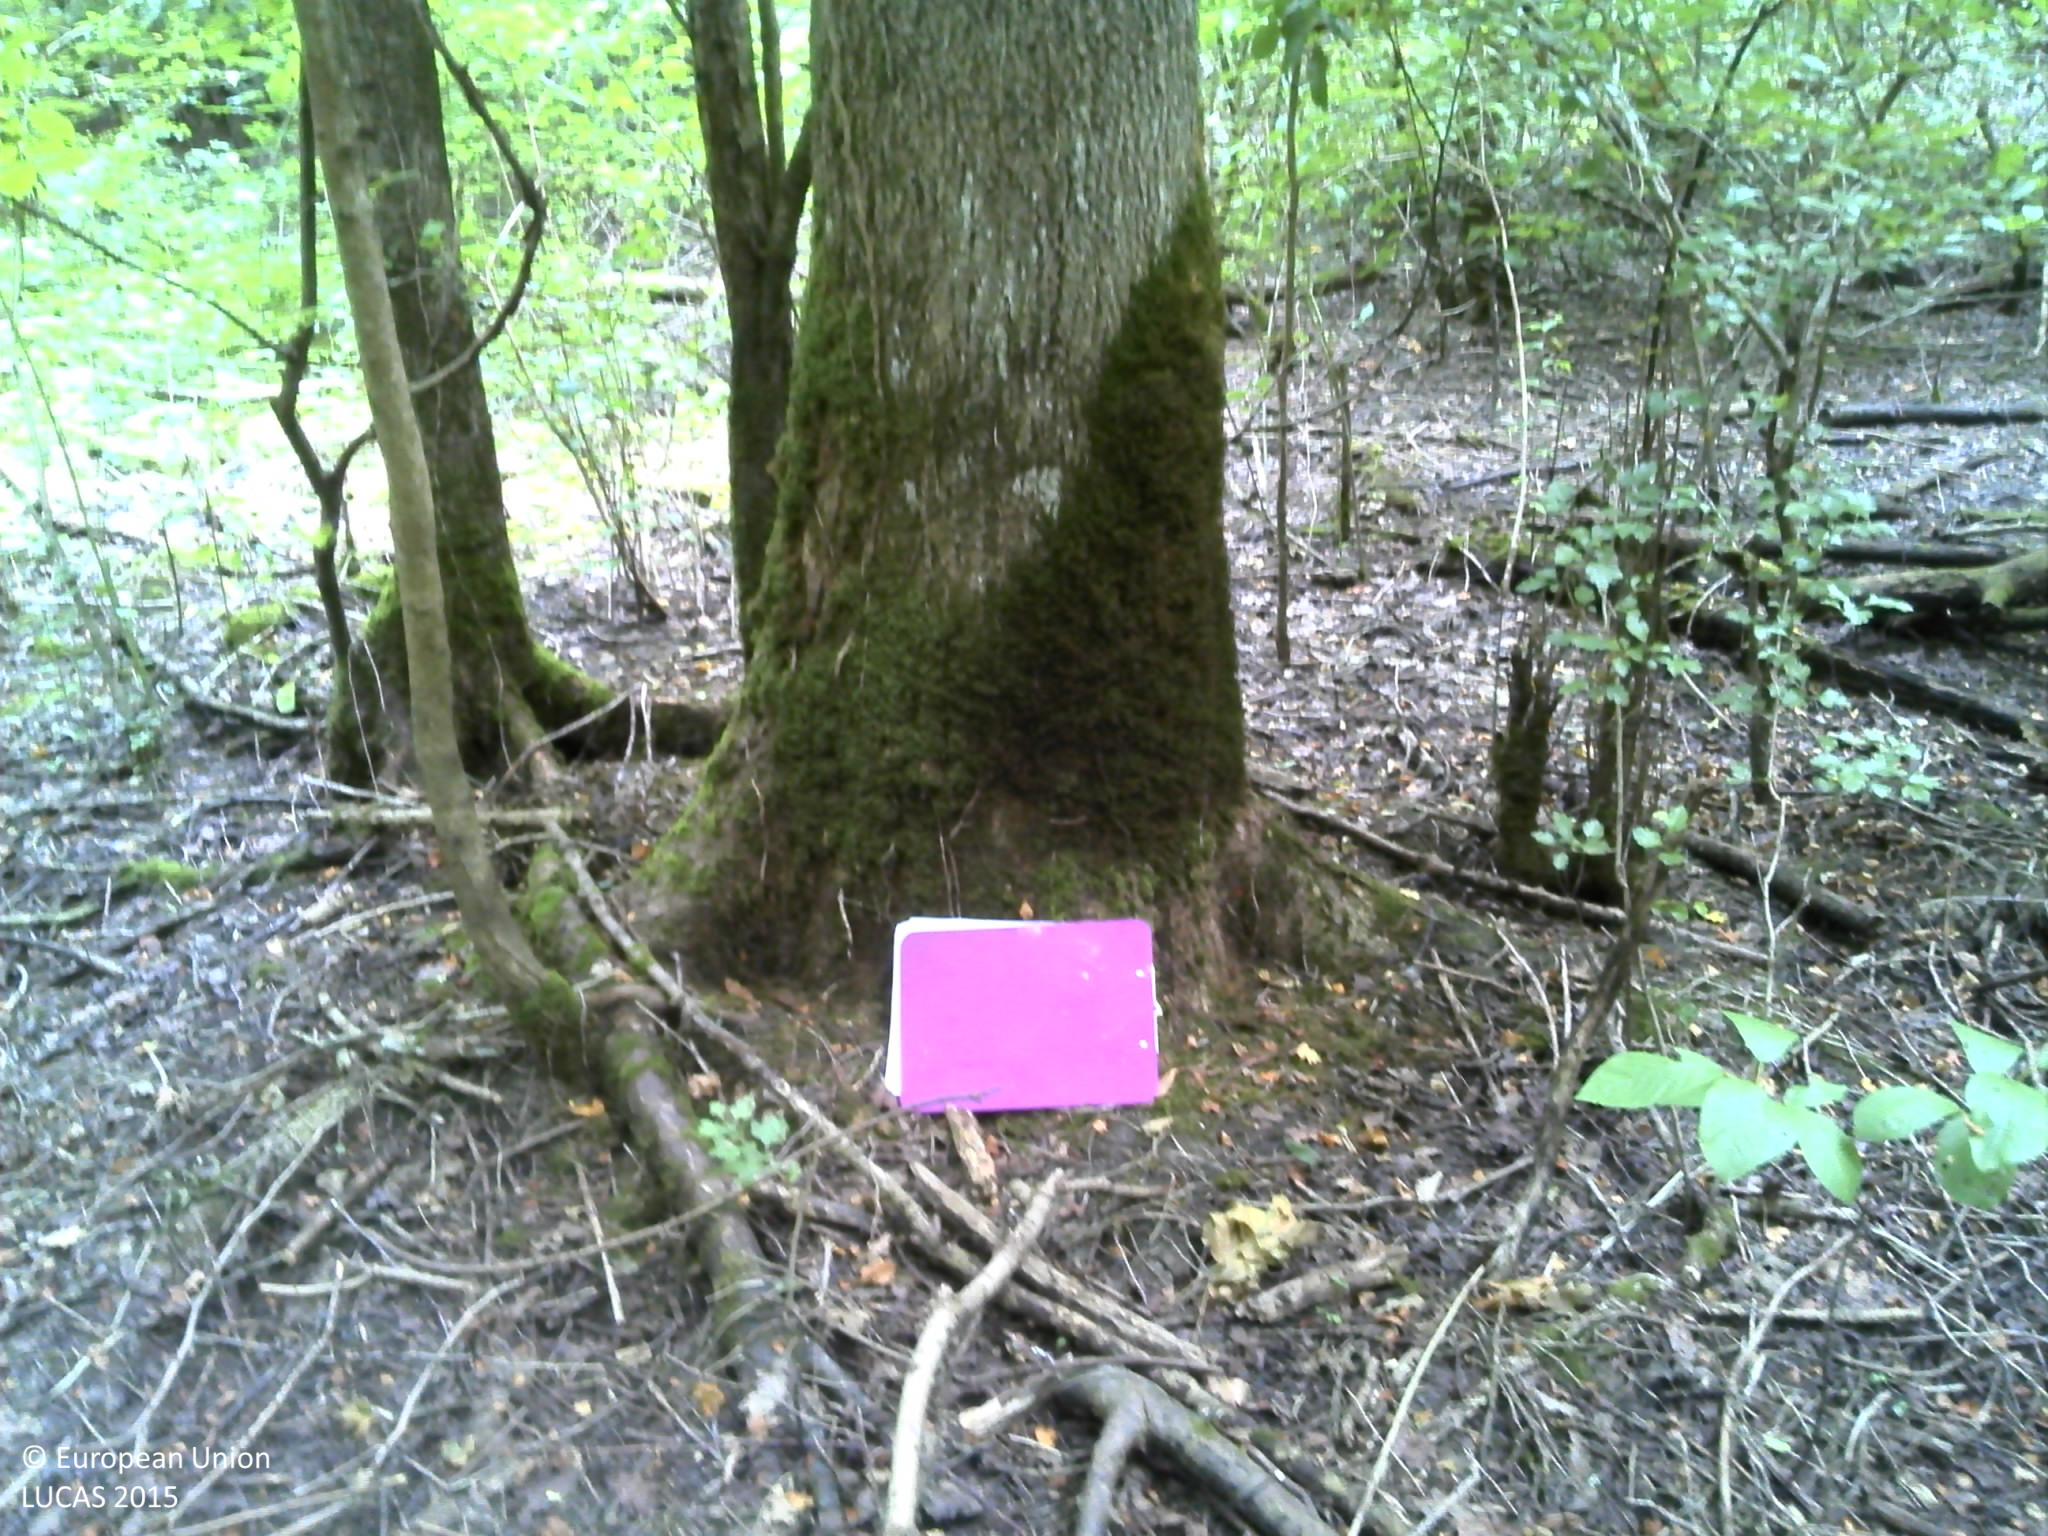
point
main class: Woodland
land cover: Broadleaved woodland
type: mesophytic deciduous forest
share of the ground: > 75 %
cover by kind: broadleaved forest trees 100 %
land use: Forestry
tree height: > 5 m
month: July
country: HR
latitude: 44.9359
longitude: 18.8125
